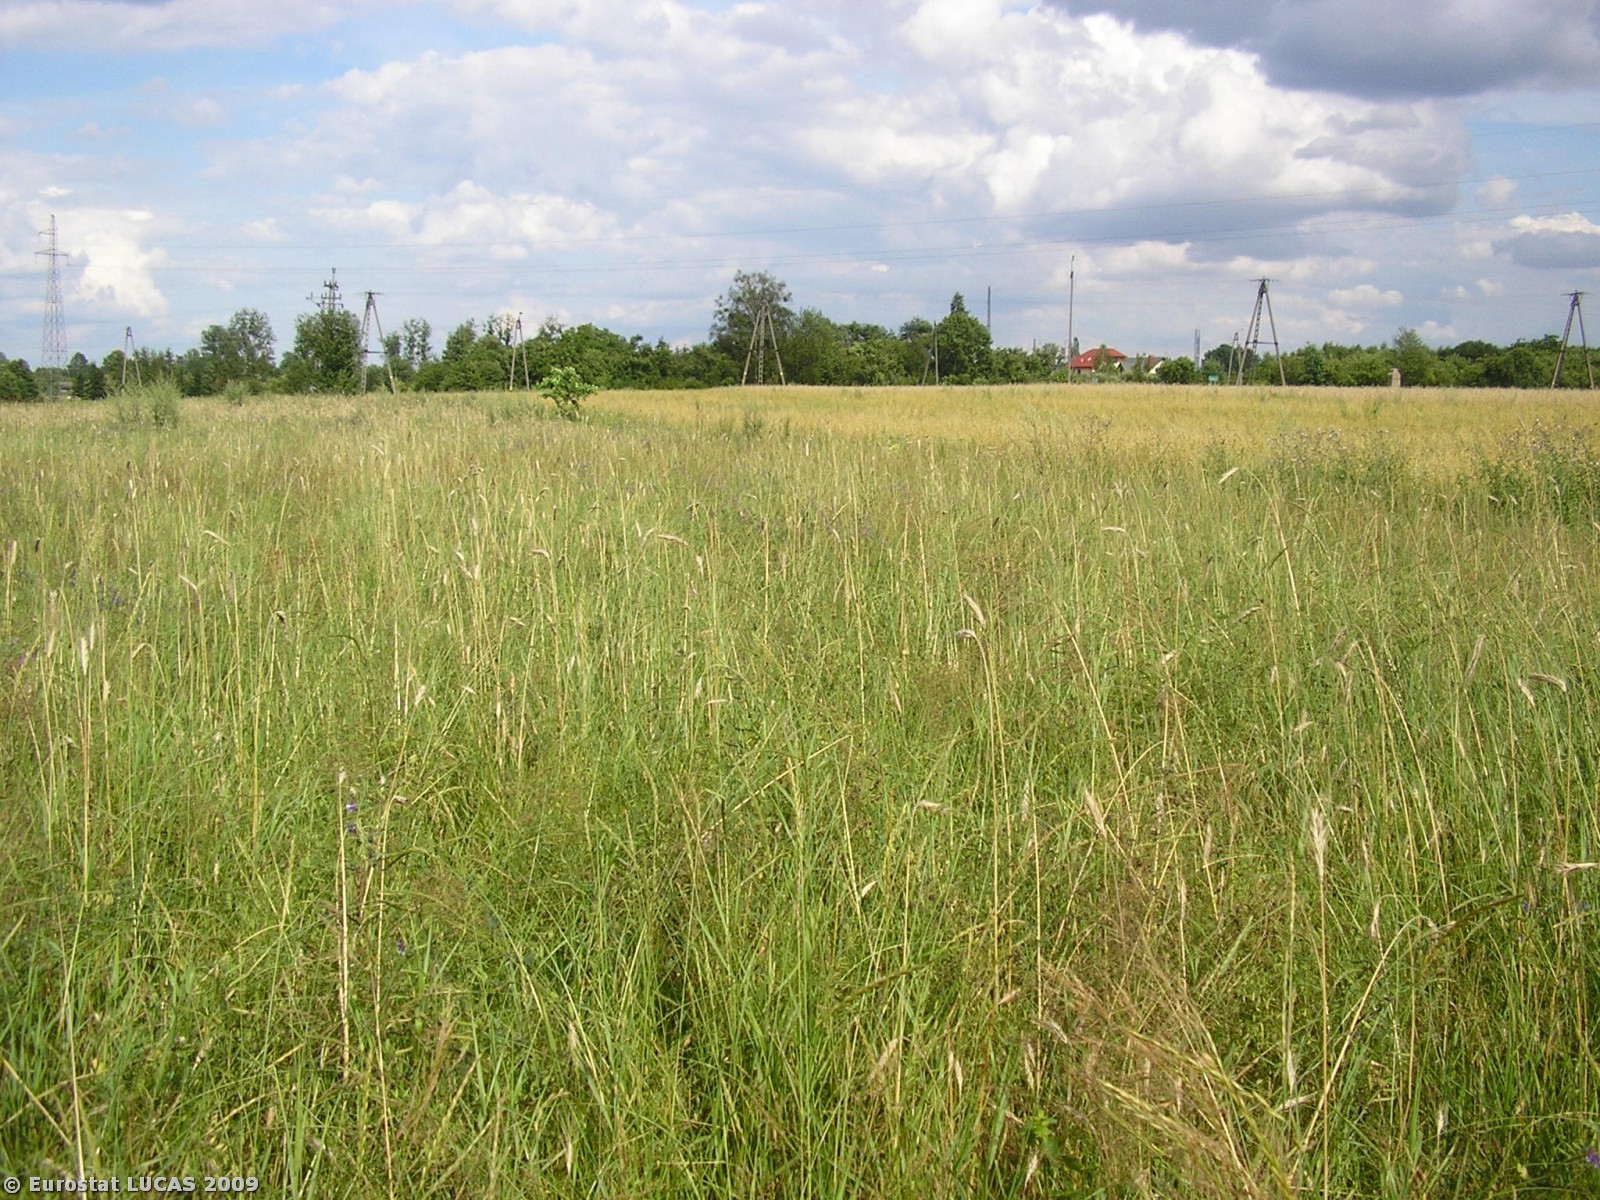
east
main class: Grassland
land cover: Grassland without tree/shrub cover
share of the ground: > 75 %
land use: Agriculture (excluding fallow land and kitchen gardens)
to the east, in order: Grassland without tree/shrub cover; Oats; Electric lines; Oats; Tracks; Clovers; Ditches and canals; Grass margins; Paved roads, cycling and walking lanes; Grass margins; Electric lines; Grassland without tree/shrub cover; Electric lines; Grassland without tree/shrub cover; Other fibre and oleaginous crops; Common wheat; Grassland with sparse tree/shrub cover
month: July
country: PL
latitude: 51.4567
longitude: 21.4634
